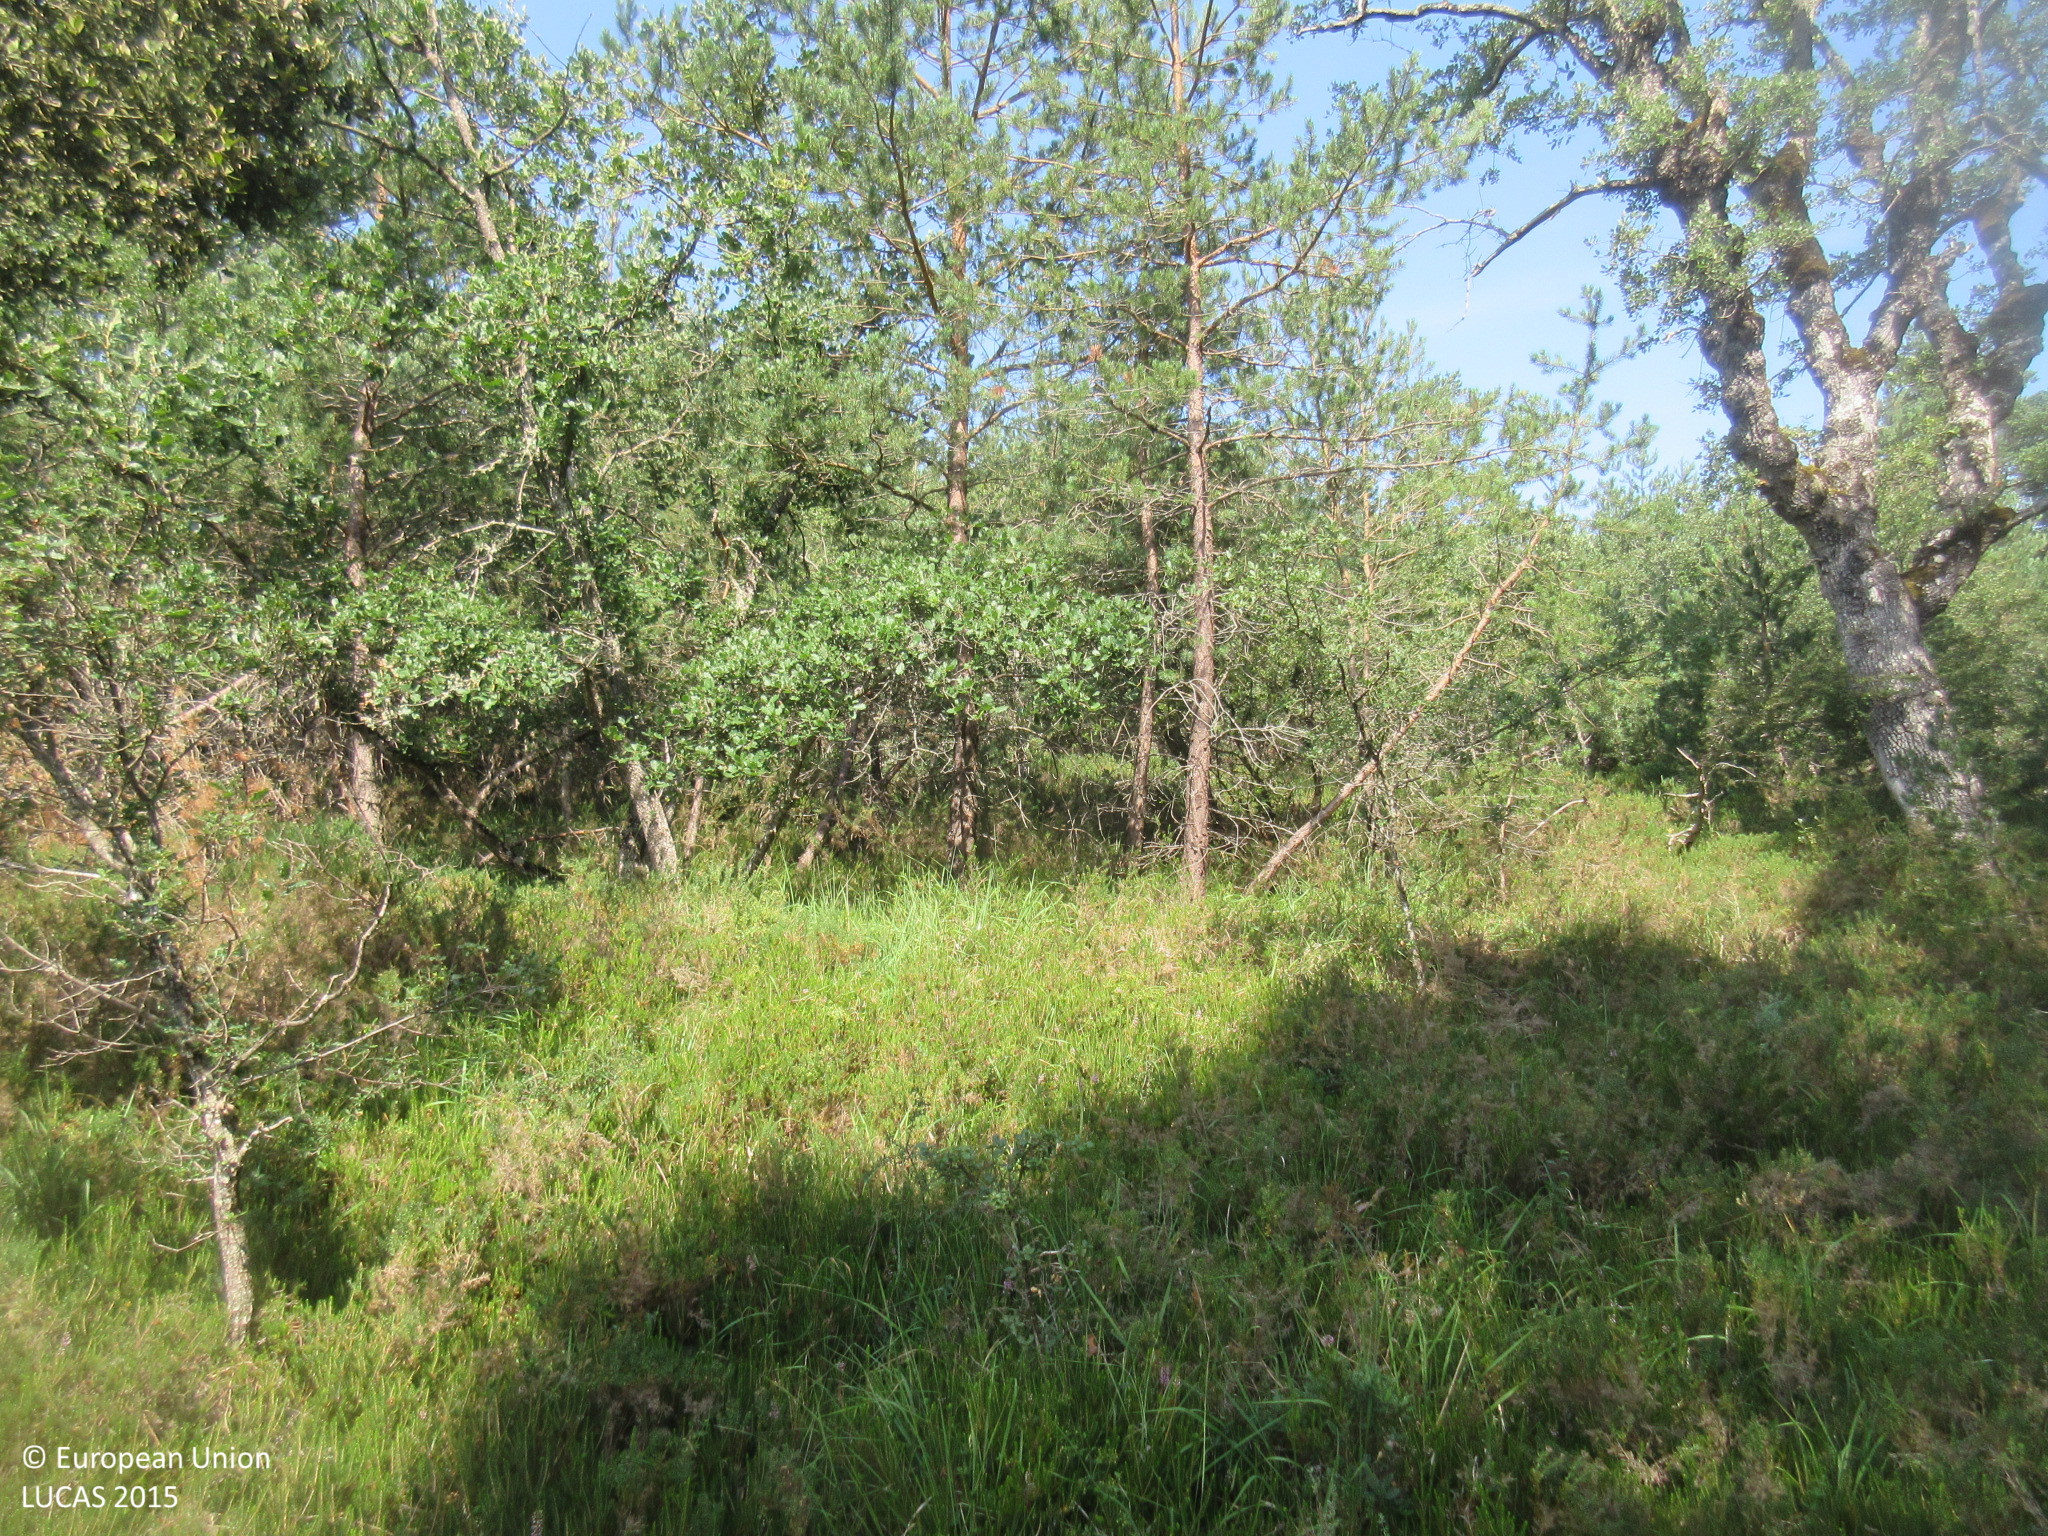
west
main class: Woodland
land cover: Broadleaved woodland
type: broadleaved evergreen forest
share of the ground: > 75 %
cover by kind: broadleaved forest trees 80 %, shrubs 20 %
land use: Forestry
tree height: > 5 m
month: July
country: ES
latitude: 42.9910
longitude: -3.3449
